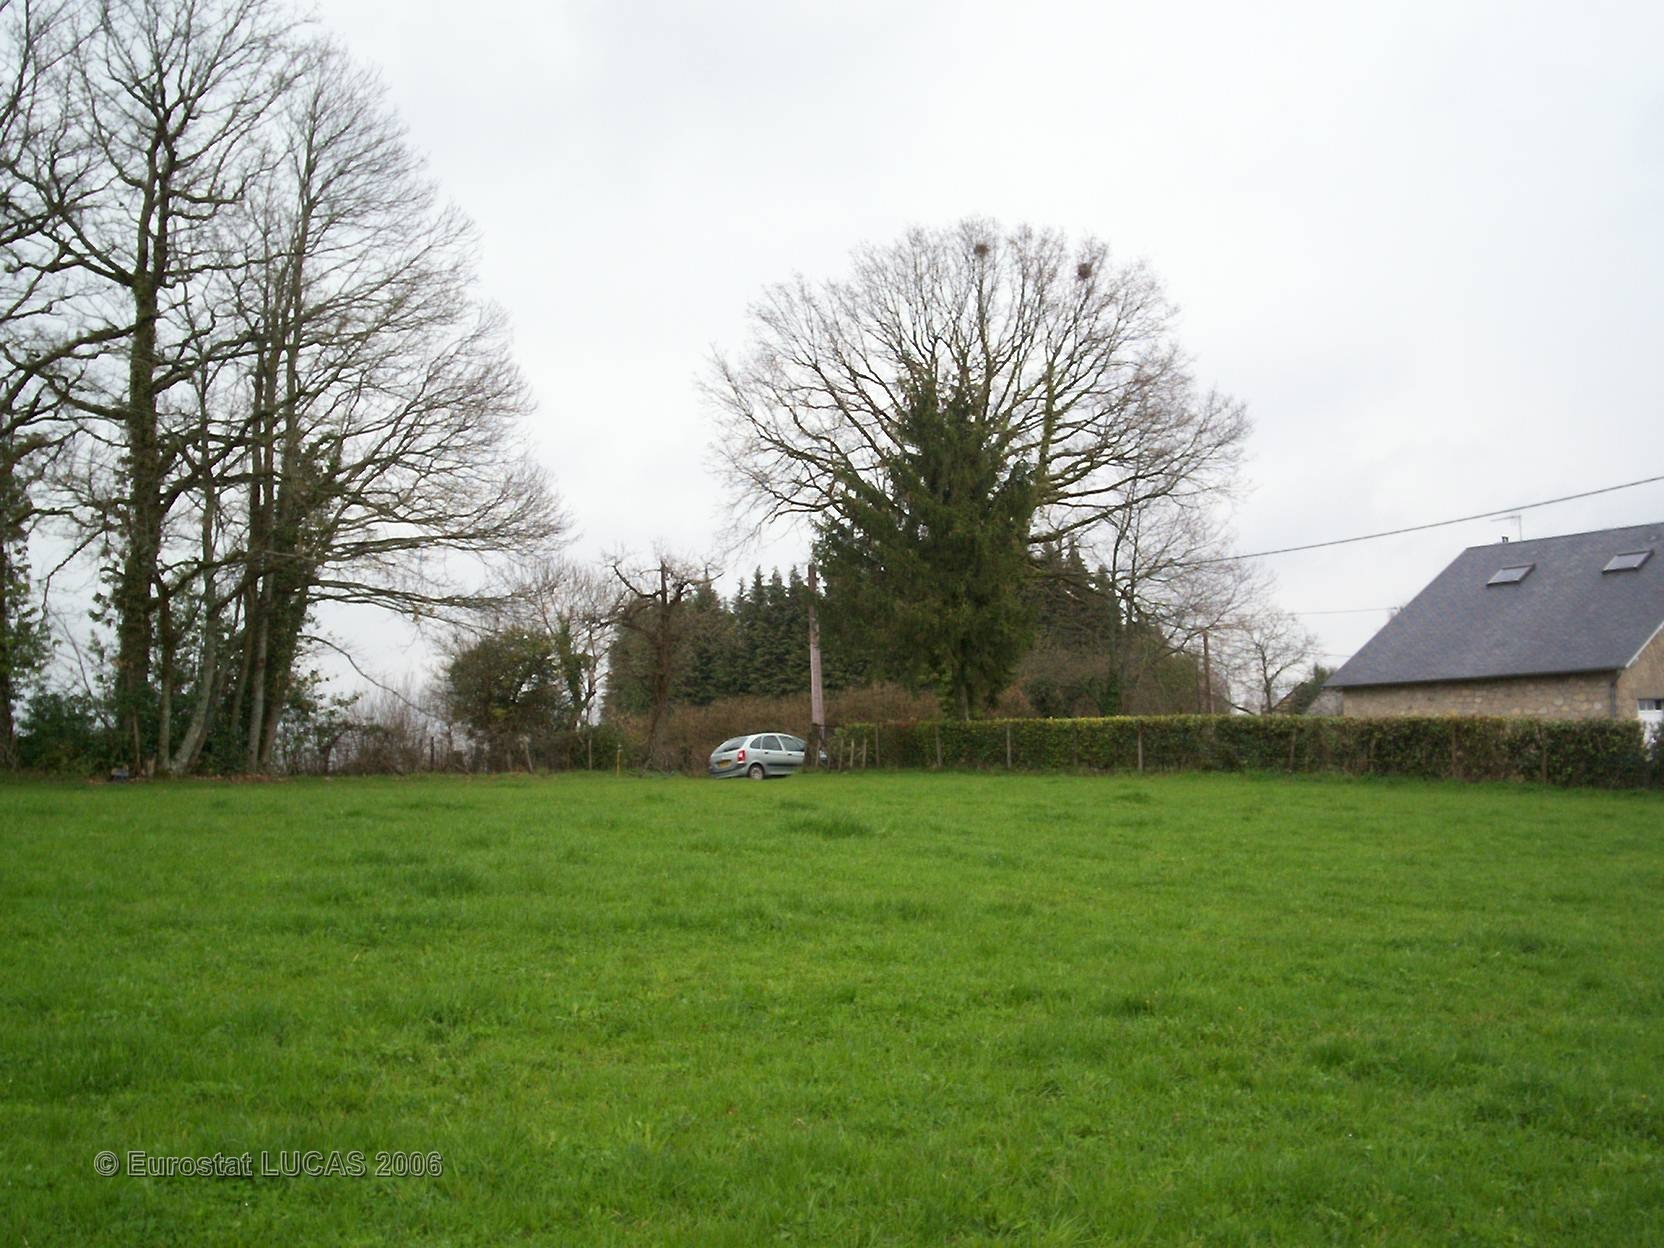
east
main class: Grassland
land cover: Grassland without tree/shrub cover
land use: Agriculture (excluding fallow land and kitchen gardens)
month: April
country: FR
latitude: 45.4962
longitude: 1.6124
